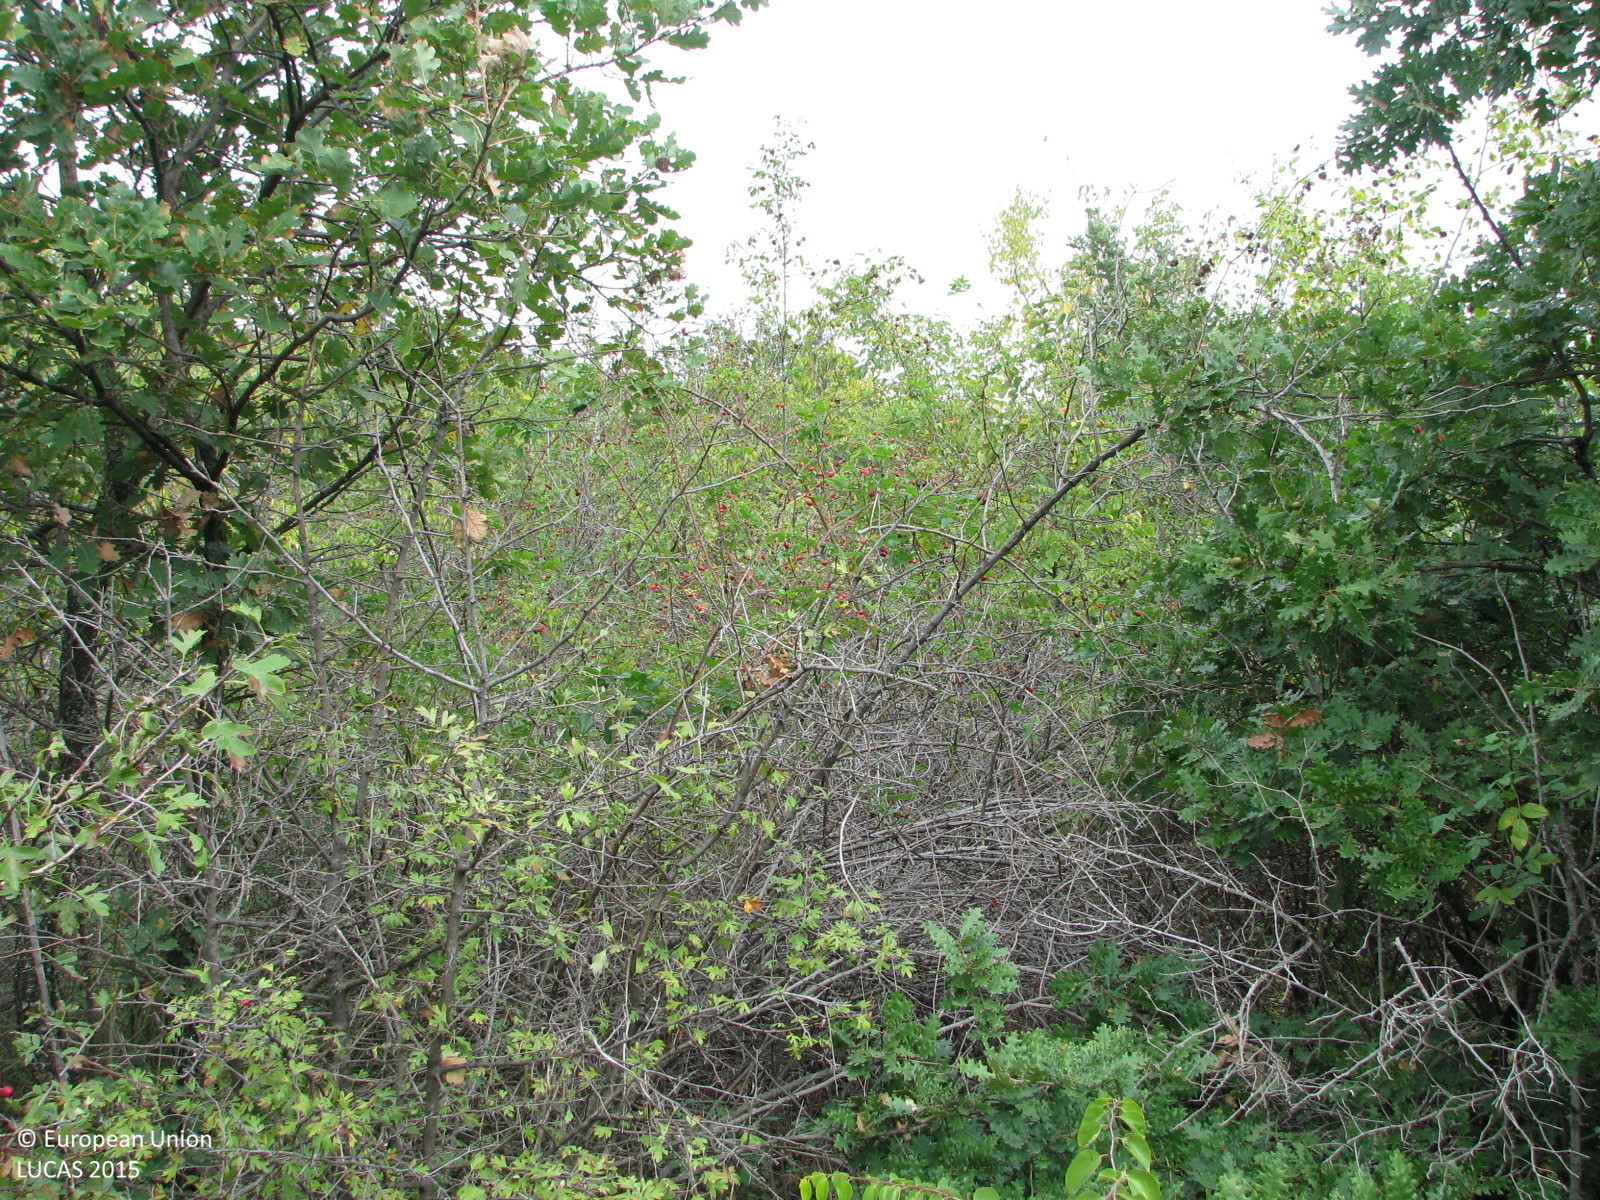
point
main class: Shrubland
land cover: Shrubland with sparse tree cover
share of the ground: > 75 %
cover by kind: shrubs 90 %, broadleaved forest trees 5 %, herbaceous plants 5 %
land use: Semi-natural and natural areas not in use
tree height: < 5 m
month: October
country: BG
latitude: 42.4124
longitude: 26.1598
